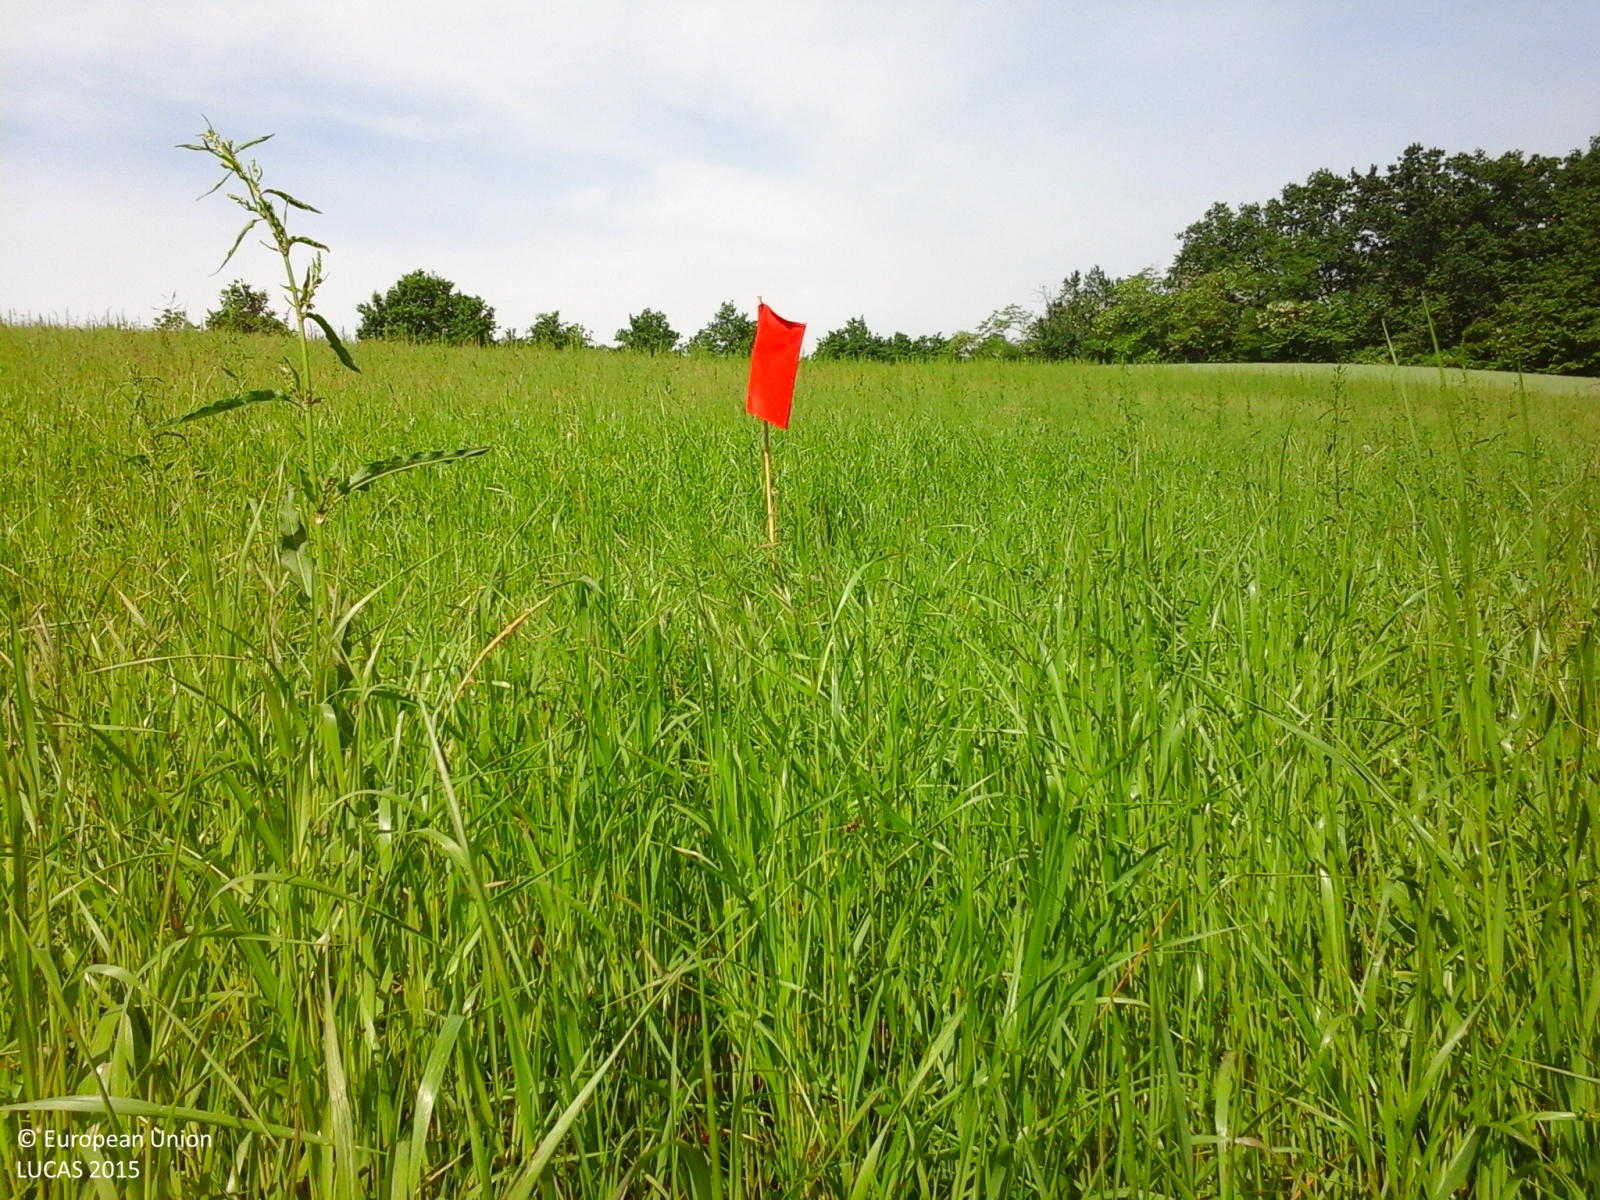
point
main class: Cropland
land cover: Temporary grasslands
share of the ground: > 75 %
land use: Agriculture (excluding fallow land and kitchen gardens)
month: May
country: IT
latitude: 44.9333
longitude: 8.3938
